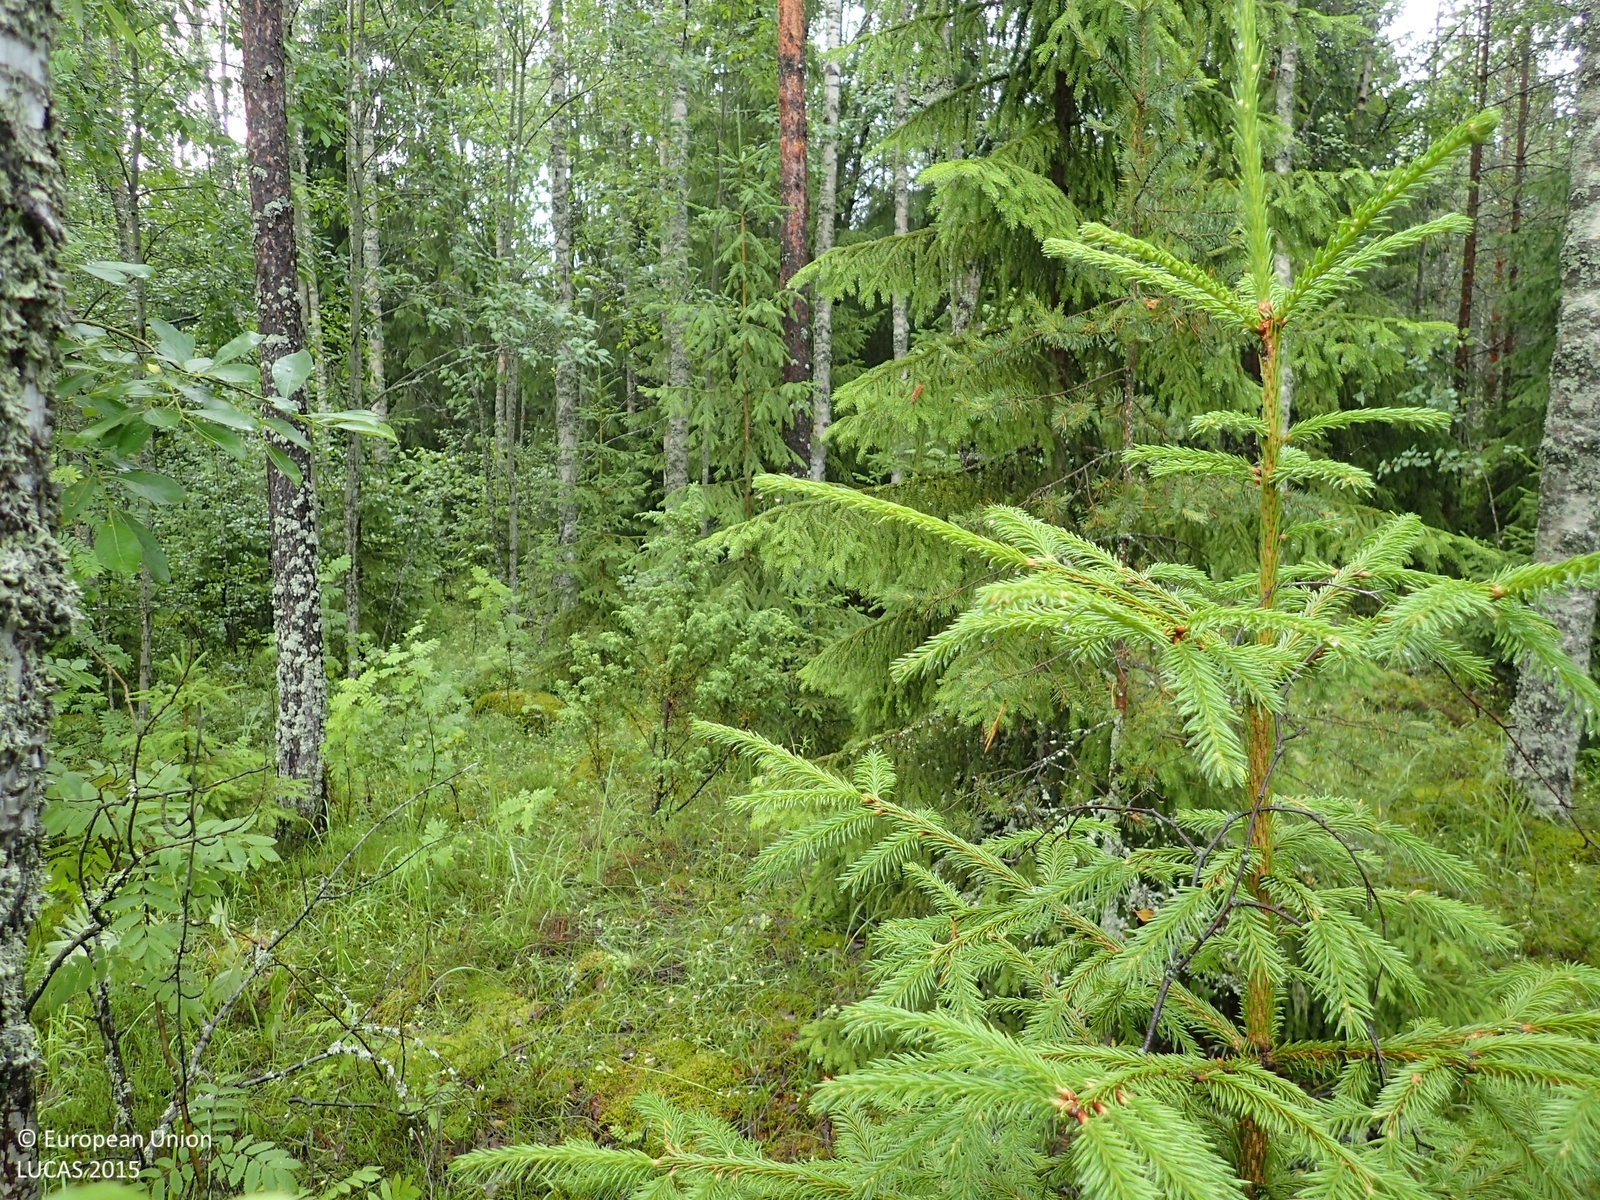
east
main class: Woodland
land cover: Pine dominated mixed woodland
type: boreal forest
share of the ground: 50 - 75 %
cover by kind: broadleaved forest trees 40 %, coniferous forest trees 20 %, shrubs 20 %, herbaceous plants 10 %, lichens and mosses 10 %
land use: Forestry
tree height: > 5 m
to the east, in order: Pine dominated mixed woodland; Spruce dominated mixed woodland; Pine dominated coniferous woodland; Tracks; Spruce dominated mixed woodland; Other mixed woodland
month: July
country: FI
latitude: 62.9826
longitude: 21.6236
